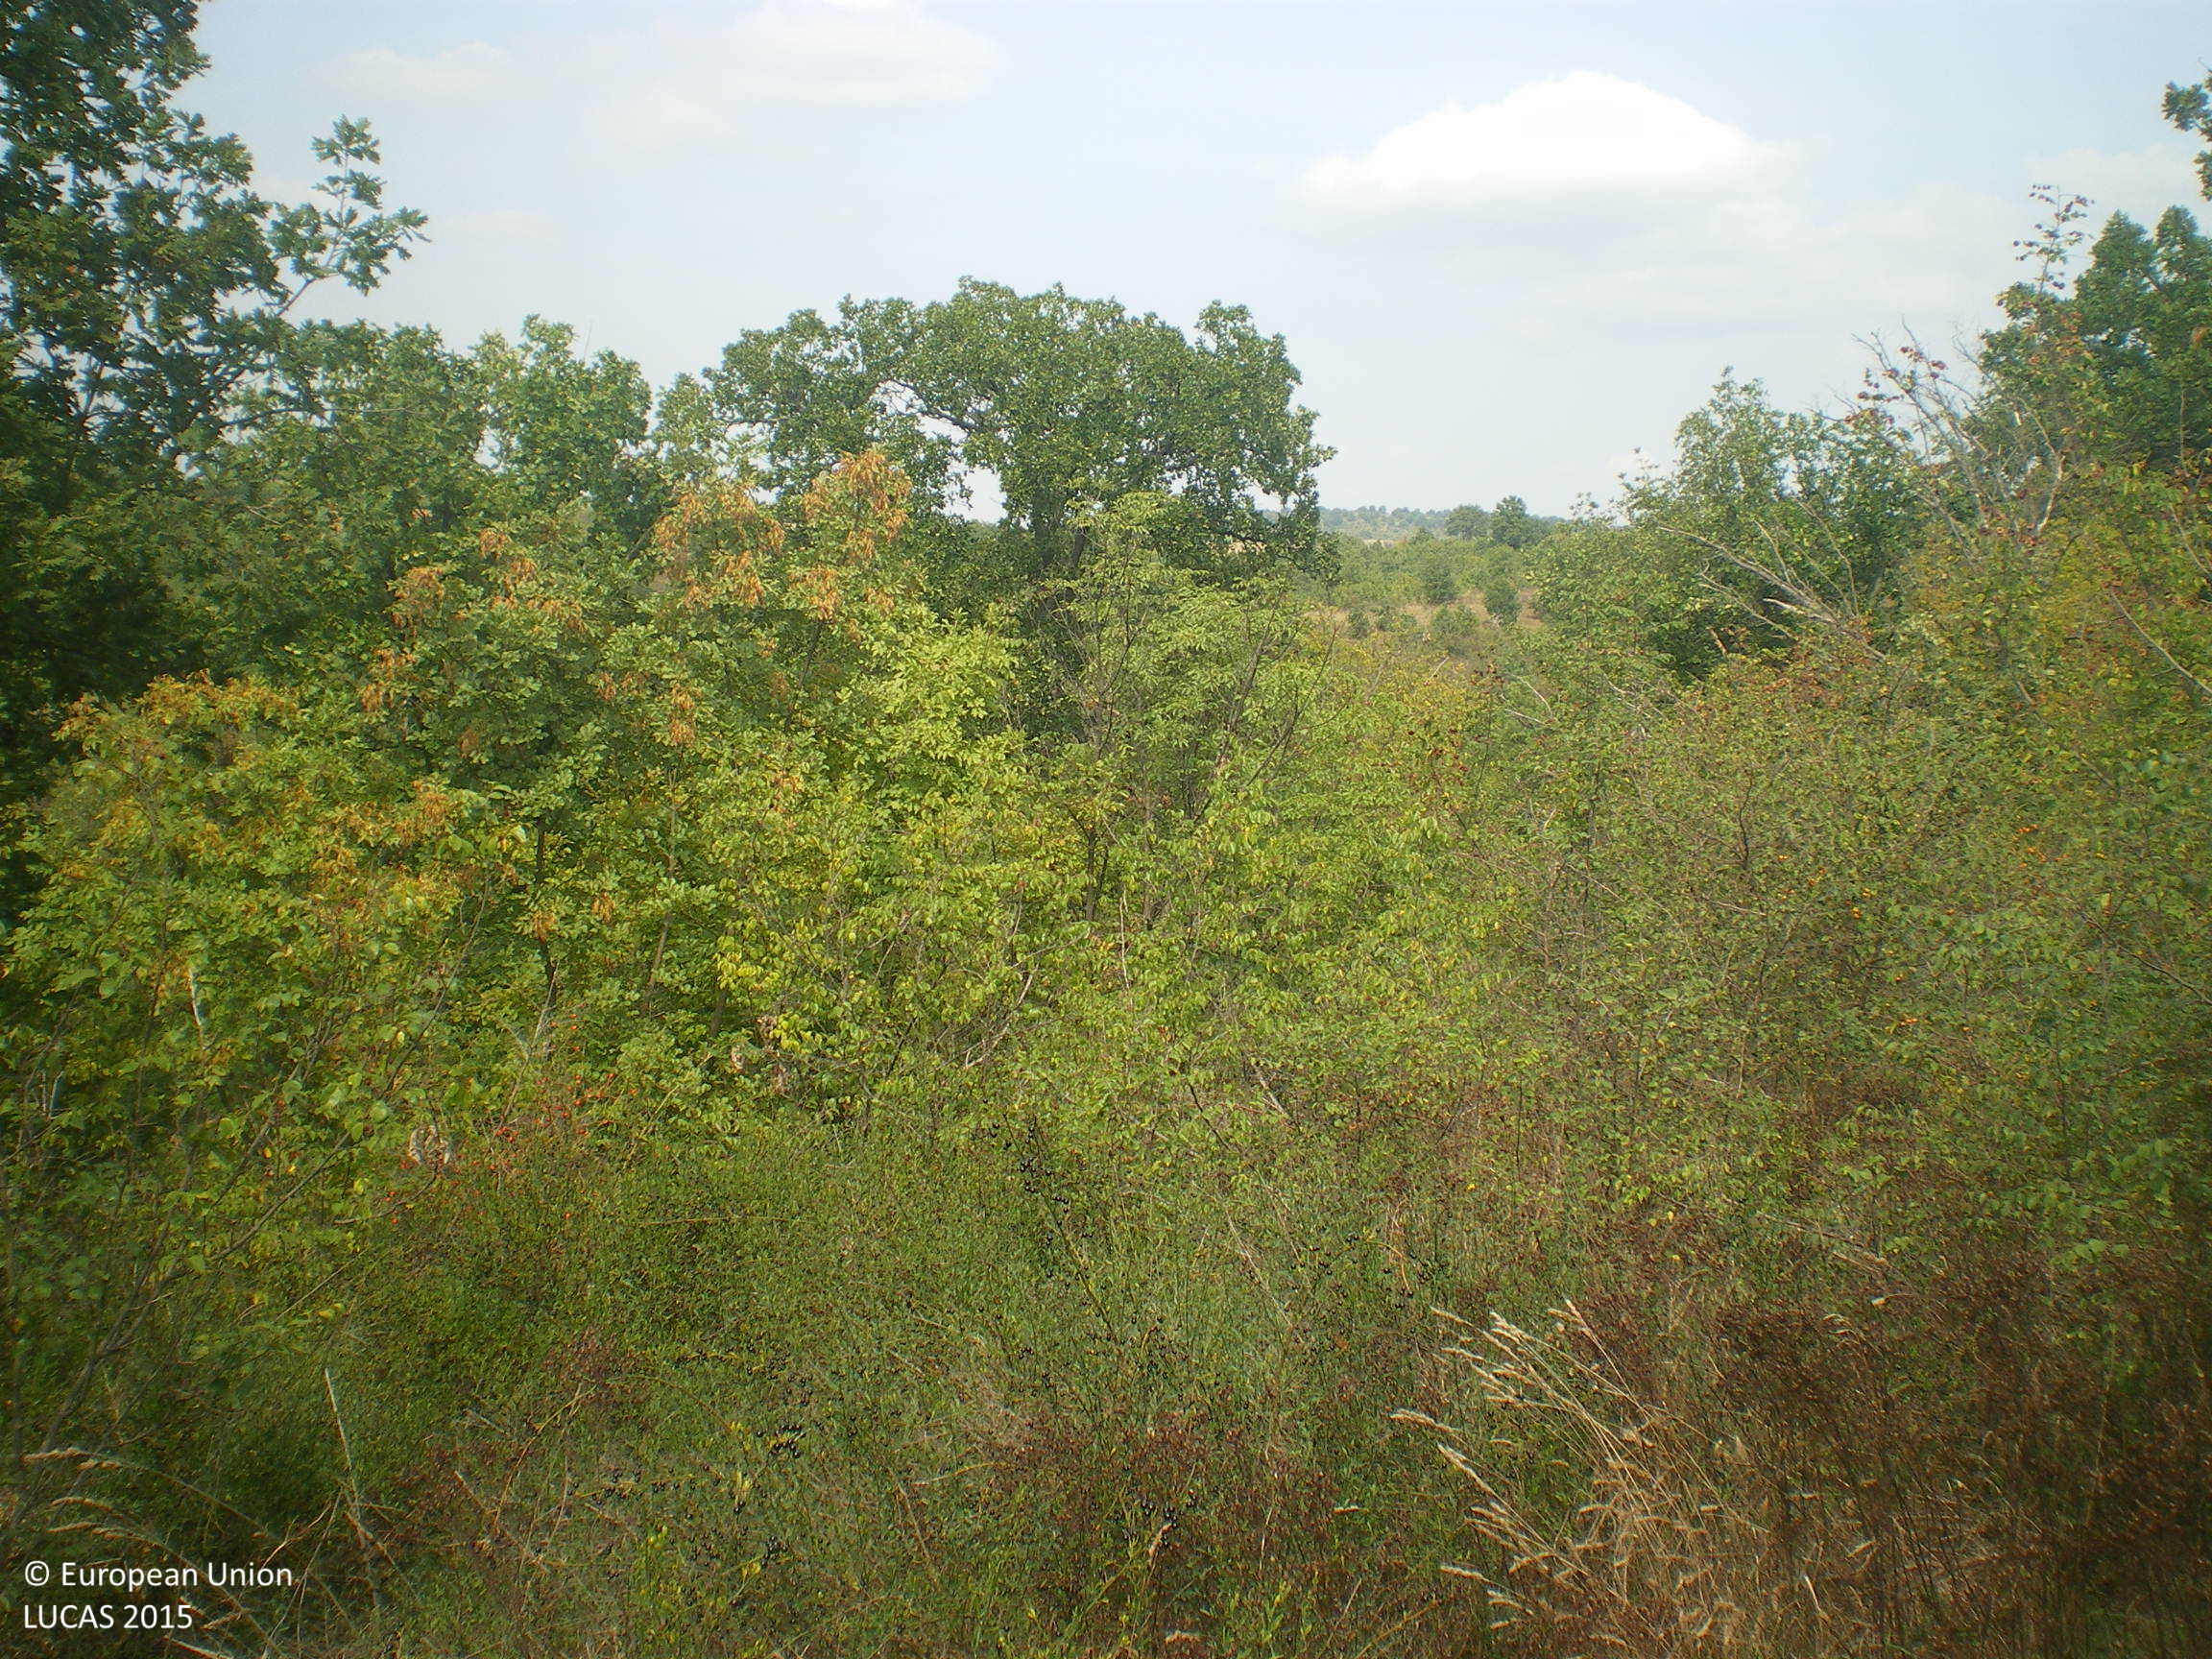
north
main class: Woodland
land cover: Broadleaved woodland
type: mesophytic deciduous forest
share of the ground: > 75 %
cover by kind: broadleaved forest trees 70 %, shrubs 20 %, herbaceous plants 10 %
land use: Semi-natural and natural areas not in use
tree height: > 5 m
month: September
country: BG
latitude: 41.8605
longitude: 25.9365
